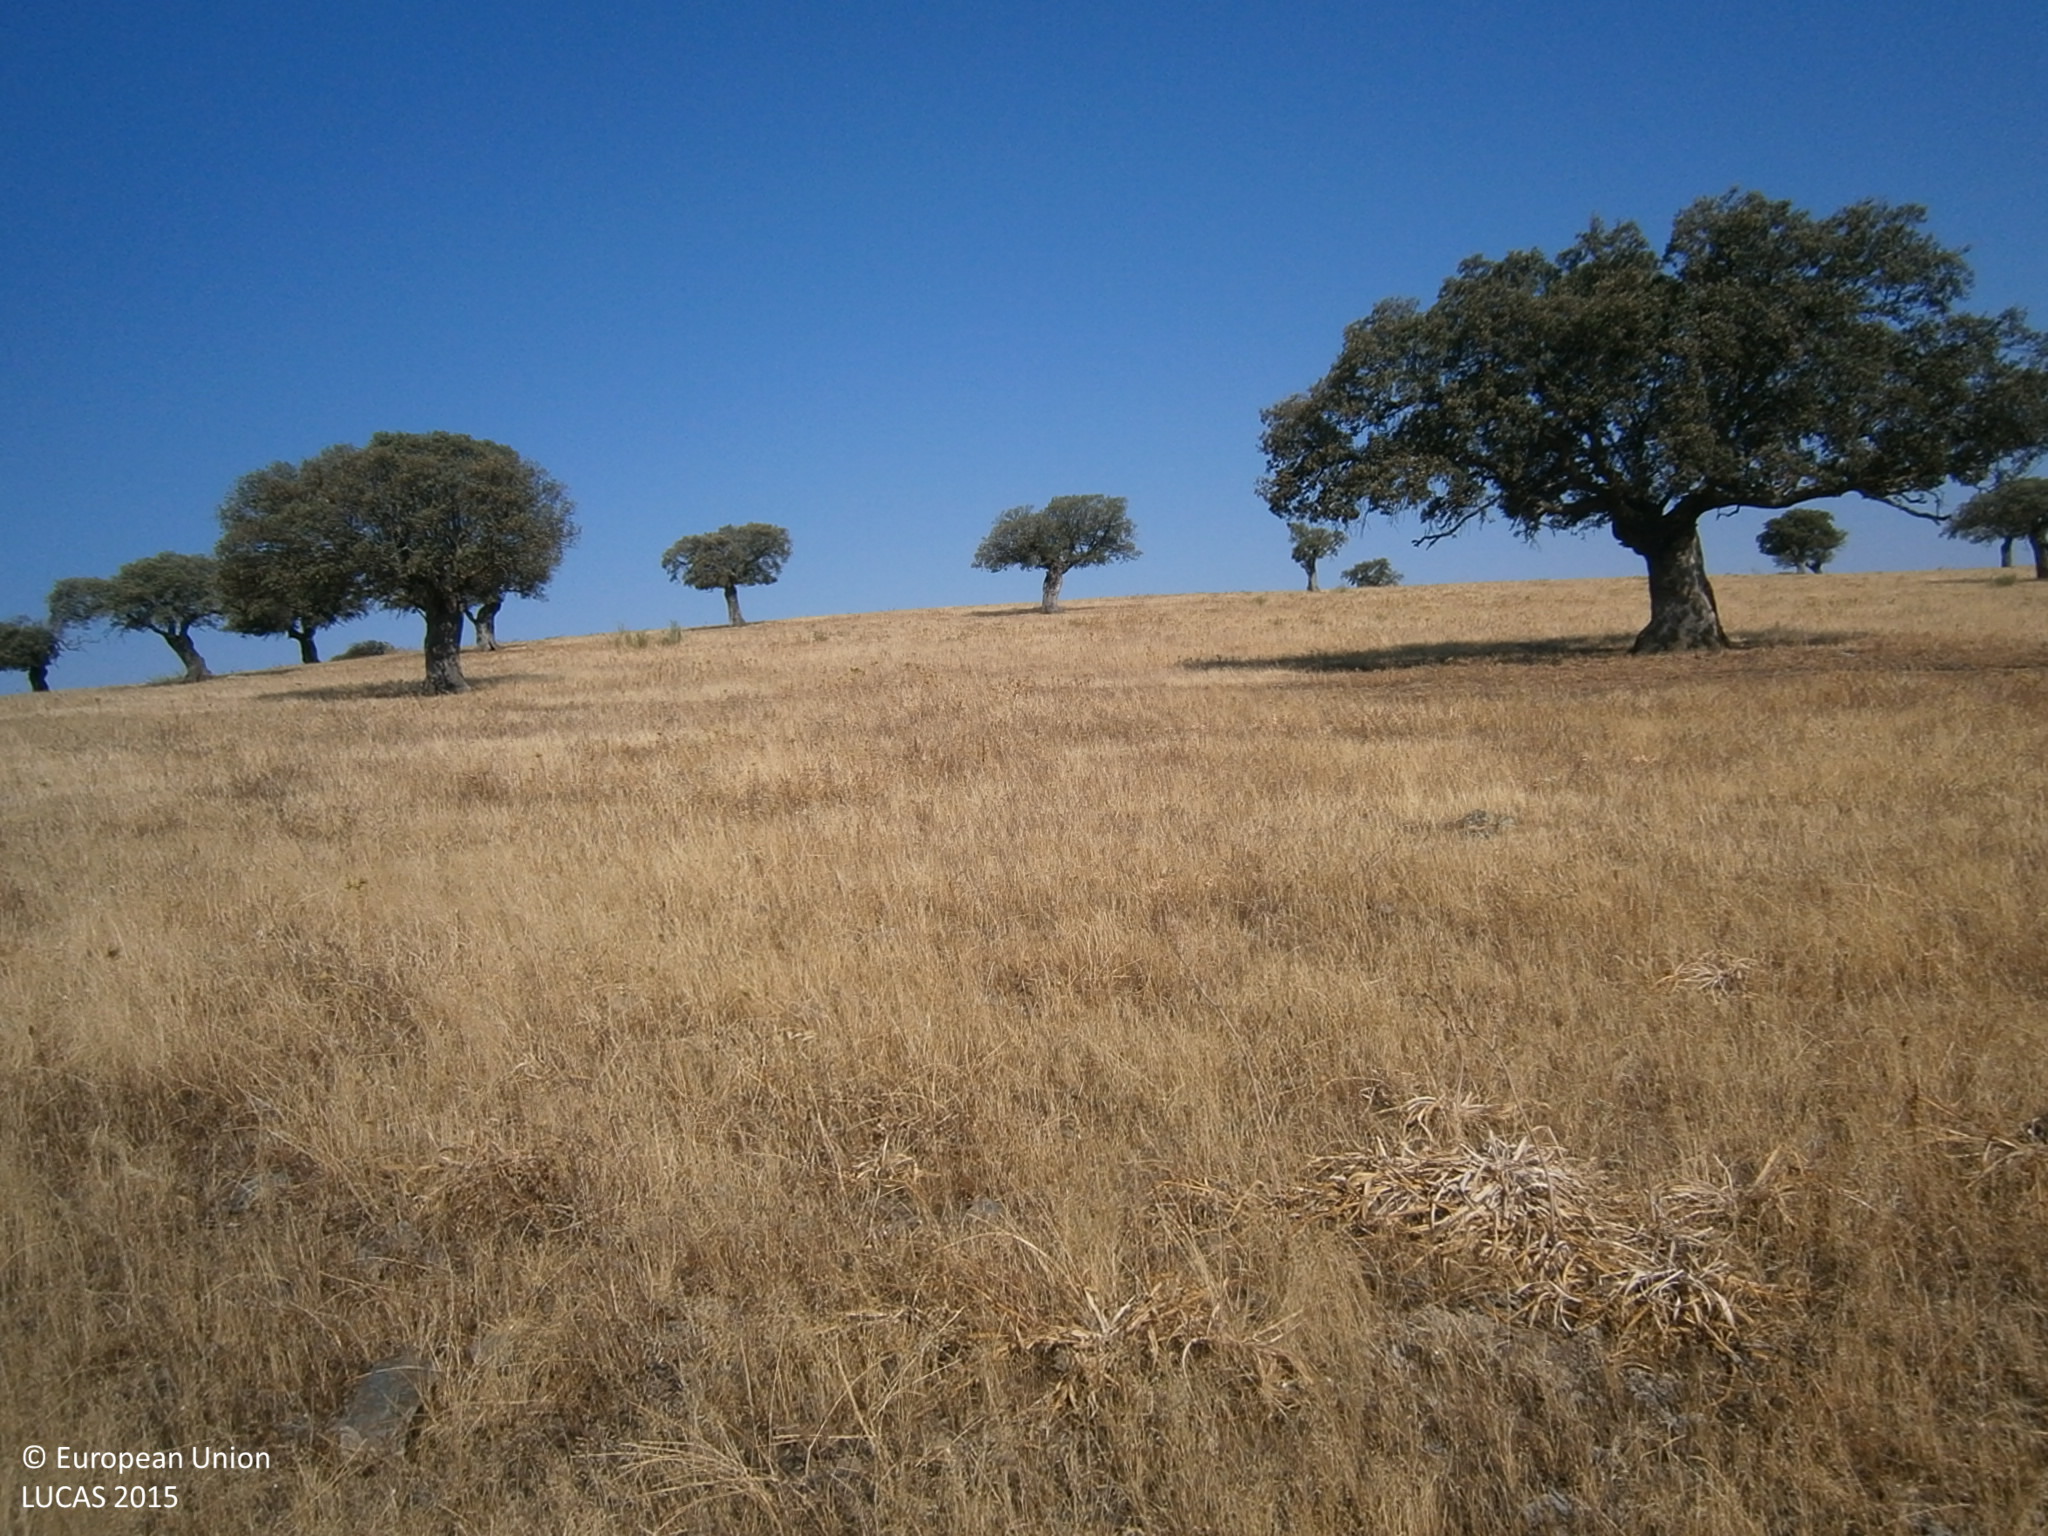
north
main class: Grassland
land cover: Grassland with sparse tree/shrub cover
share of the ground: > 75 %
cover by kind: herbaceous plants 90 %, broadleaved forest trees 5 %, shrubs 5 %
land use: Agriculture (excluding fallow land and kitchen gardens)
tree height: > 5 m
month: June
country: ES
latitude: 38.5997
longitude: -6.7202
